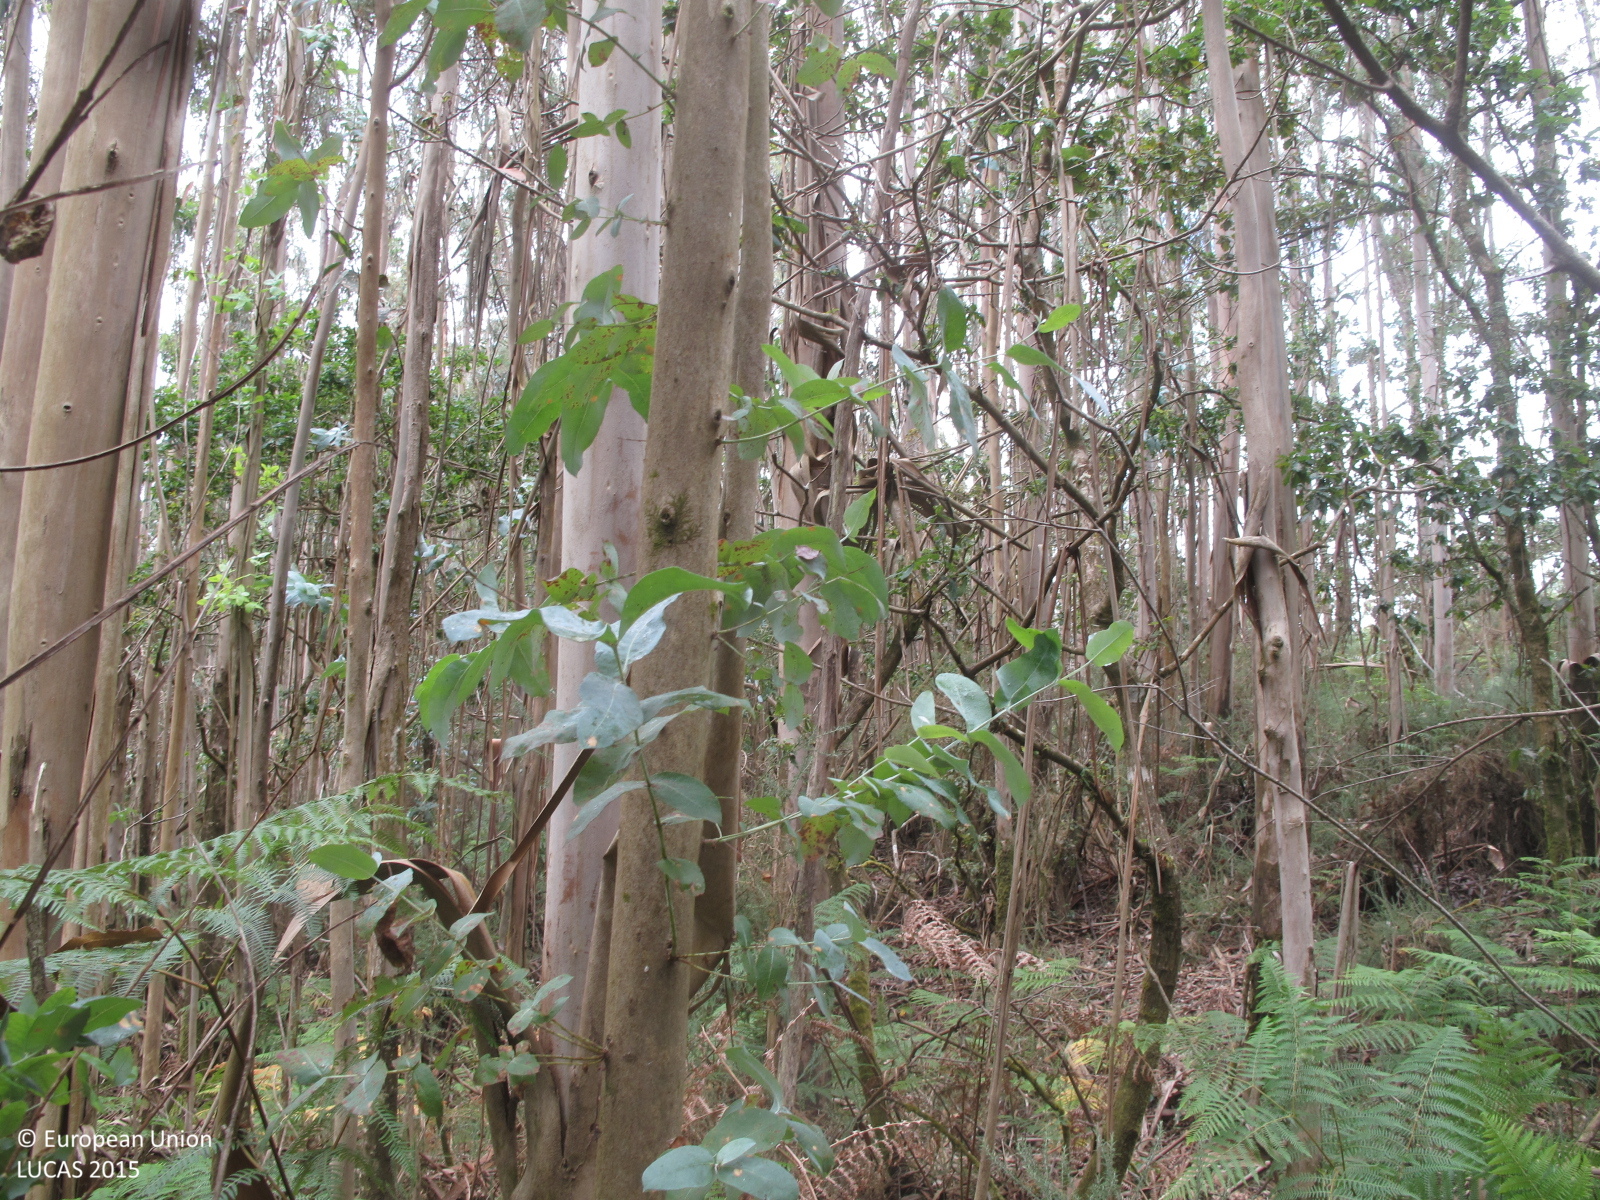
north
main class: Woodland
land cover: Broadleaved woodland
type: exotic forest
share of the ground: 50 - 75 %
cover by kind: broadleaved forest trees 60 %, herbaceous plants 20 %, shrubs 10 %, unconsolidated bare surface 10 %
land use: Forestry
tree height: > 5 m
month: July
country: ES
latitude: 42.9419
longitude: -9.2087
